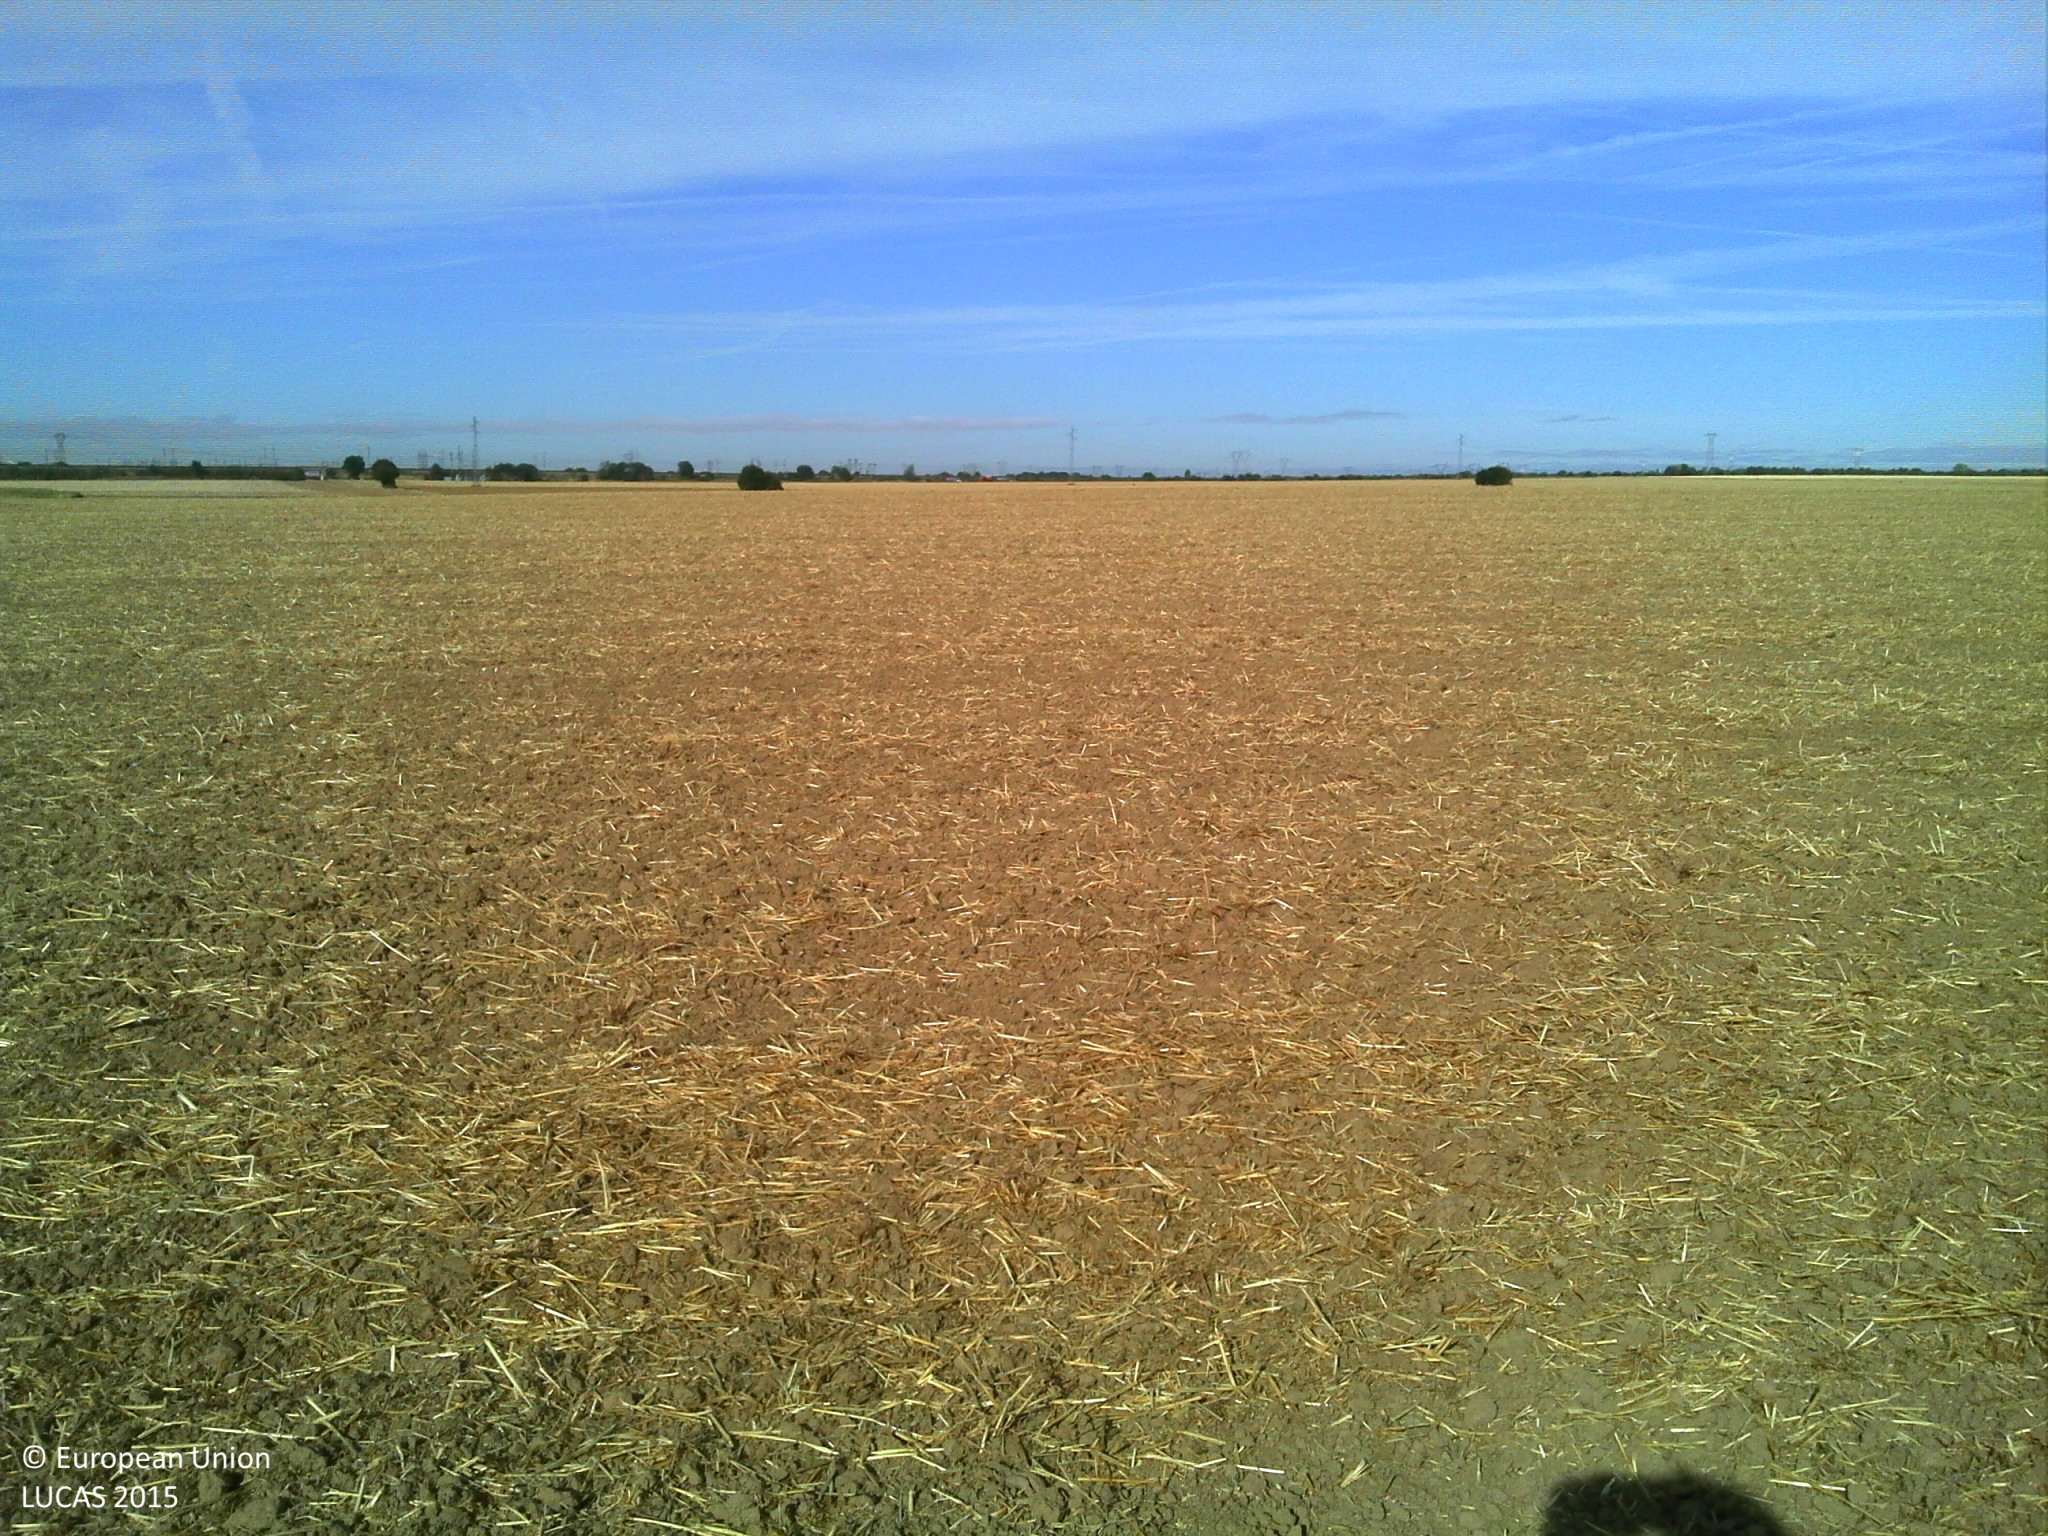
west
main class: Cropland
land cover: Common wheat
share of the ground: > 75 %
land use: Agriculture (excluding fallow land and kitchen gardens)
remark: Harvested field
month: August
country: FR
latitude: 48.9862
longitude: 2.5963
